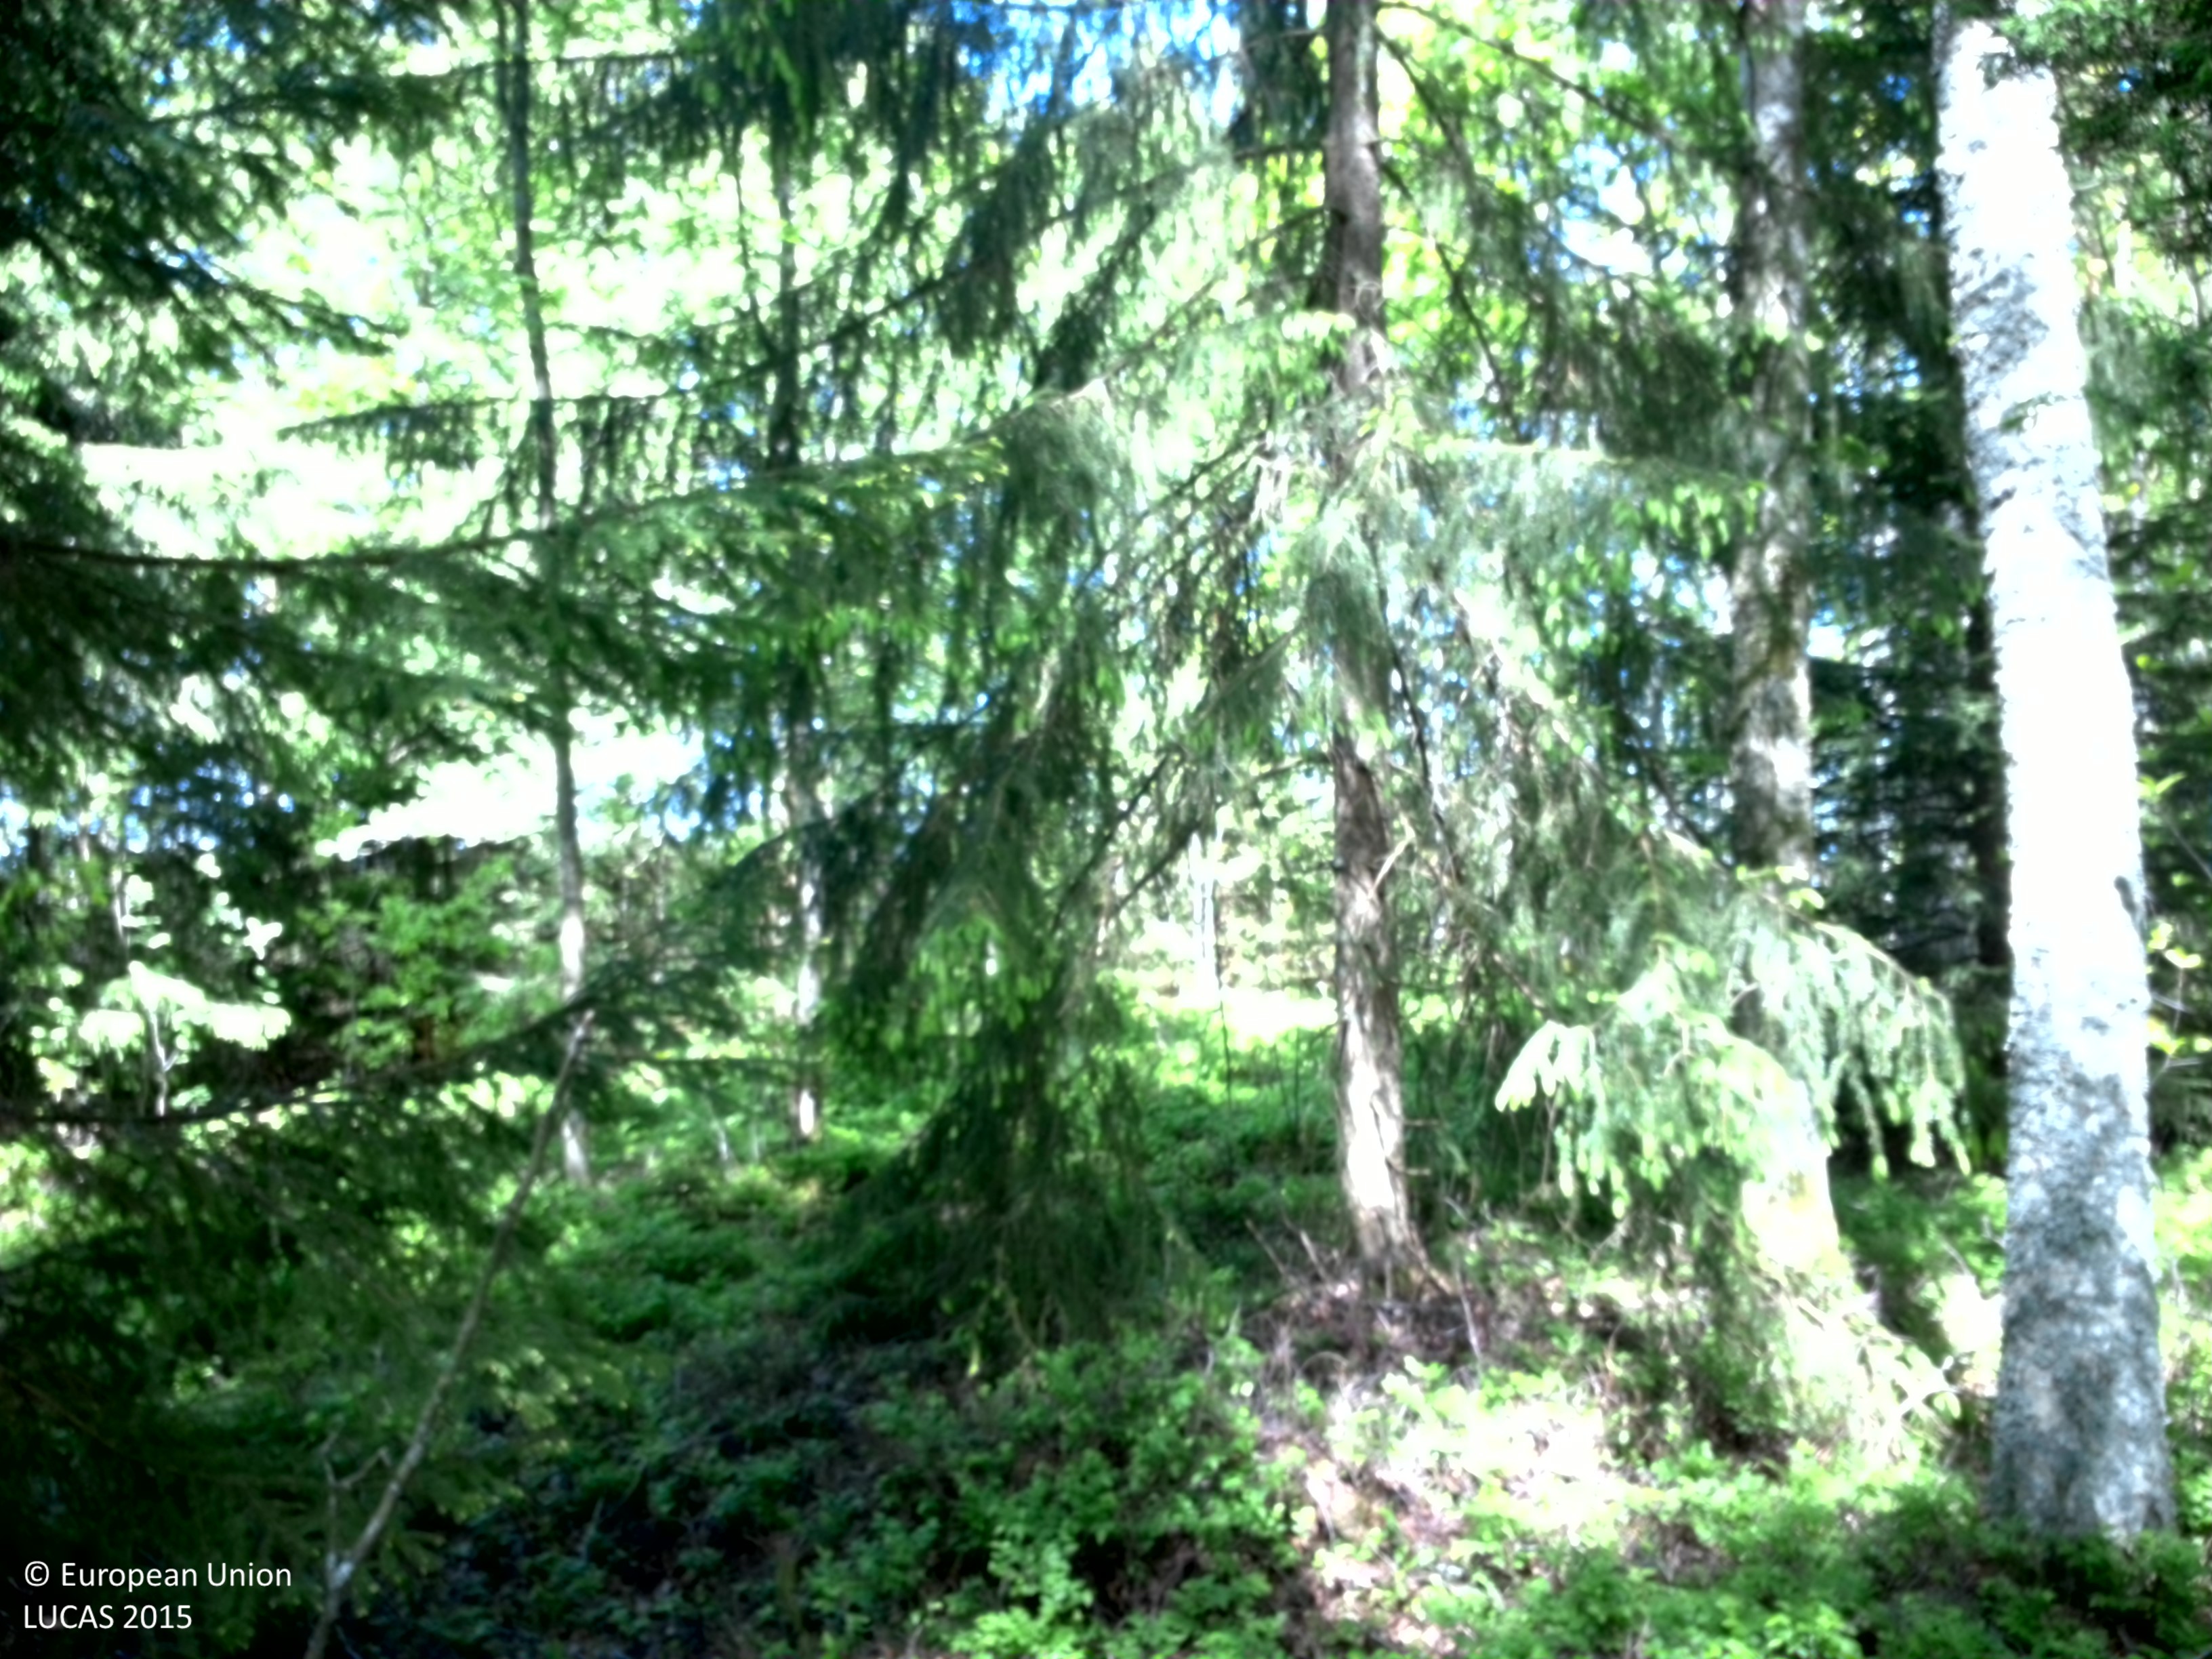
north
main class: Woodland
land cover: Spruce dominated mixed woodland
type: boreal forest
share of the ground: 50 - 75 %
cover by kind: broadleaved forest trees 40 %, coniferous forest trees 25 %, shrubs 20 %, lichens and mosses 10 %, herbaceous plants 5 %
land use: Forestry
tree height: > 5 m
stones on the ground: < 10 %
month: June
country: SE
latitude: 56.6596
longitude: 14.7122
